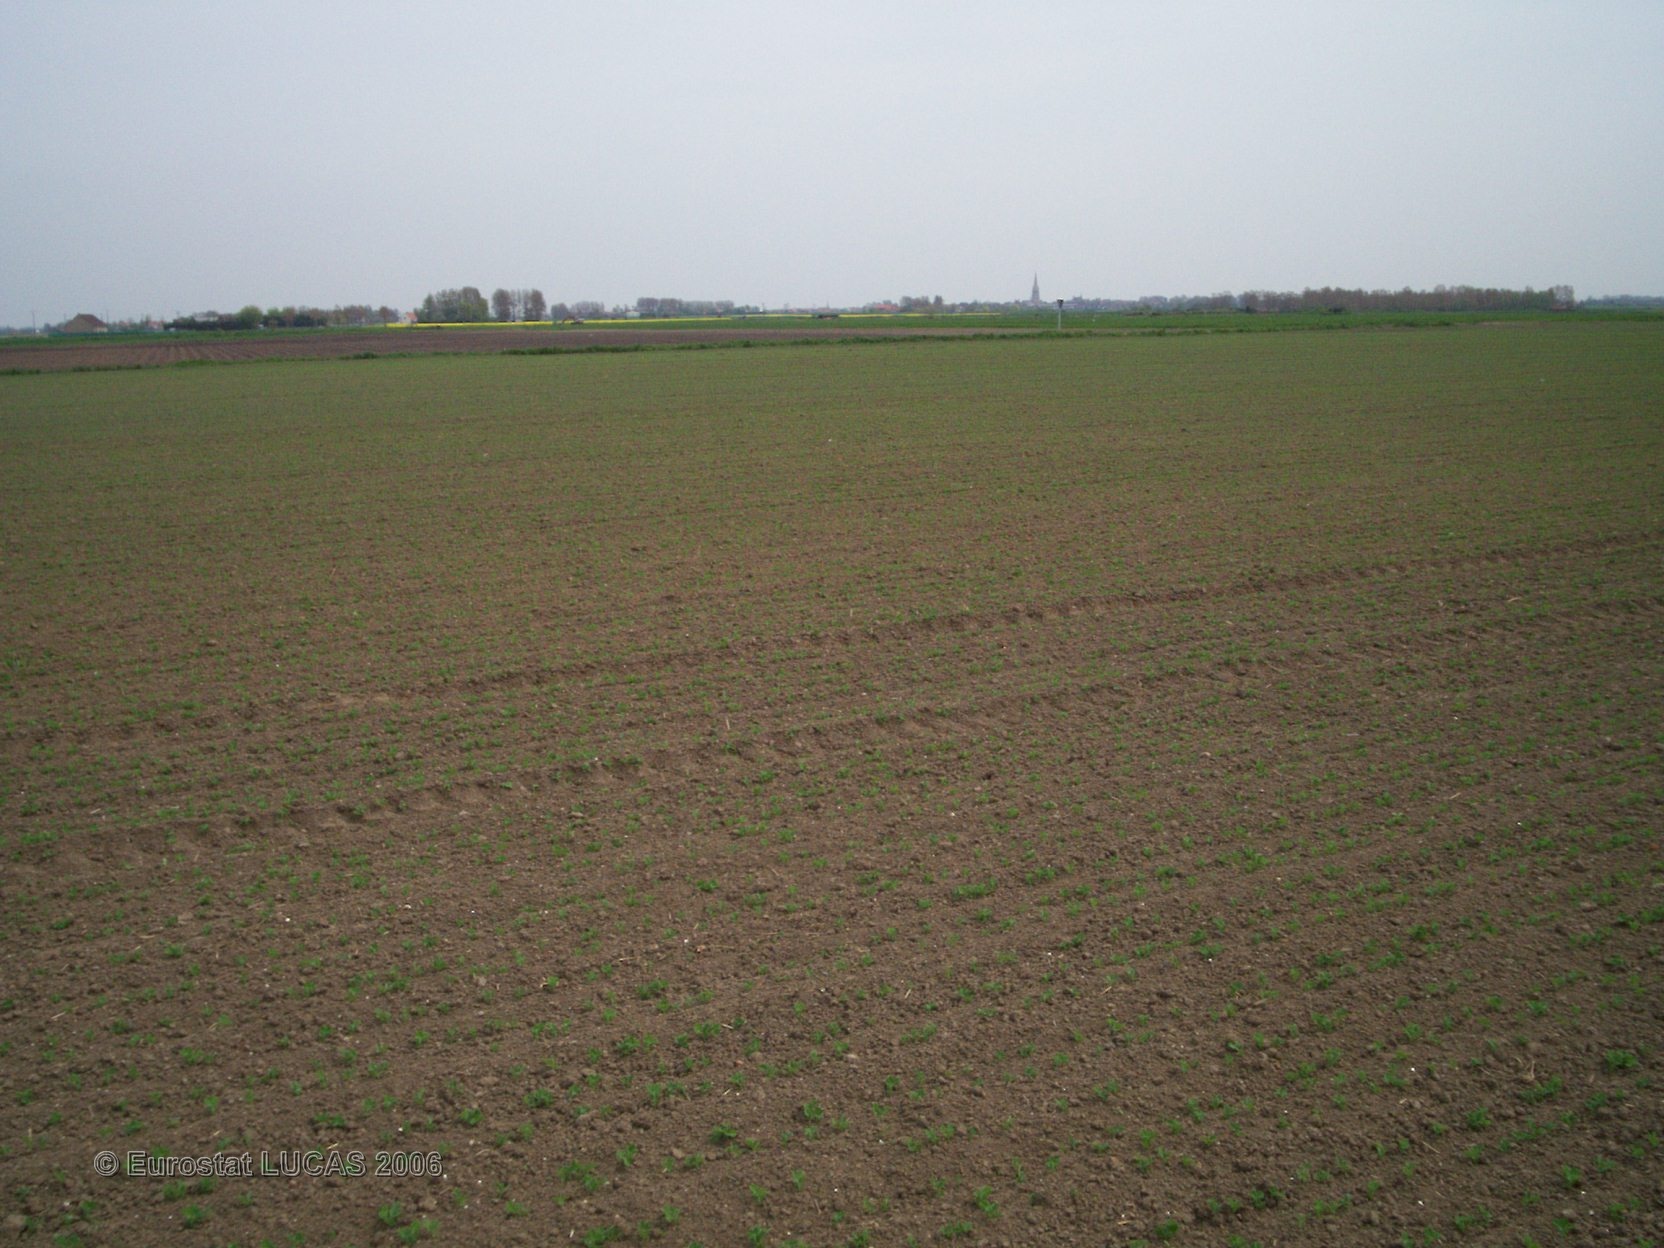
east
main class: Cropland
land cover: Dry pulses
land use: Agriculture (excluding fallow land and kitchen gardens)
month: May
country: FR
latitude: 50.9869
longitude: 2.5369
